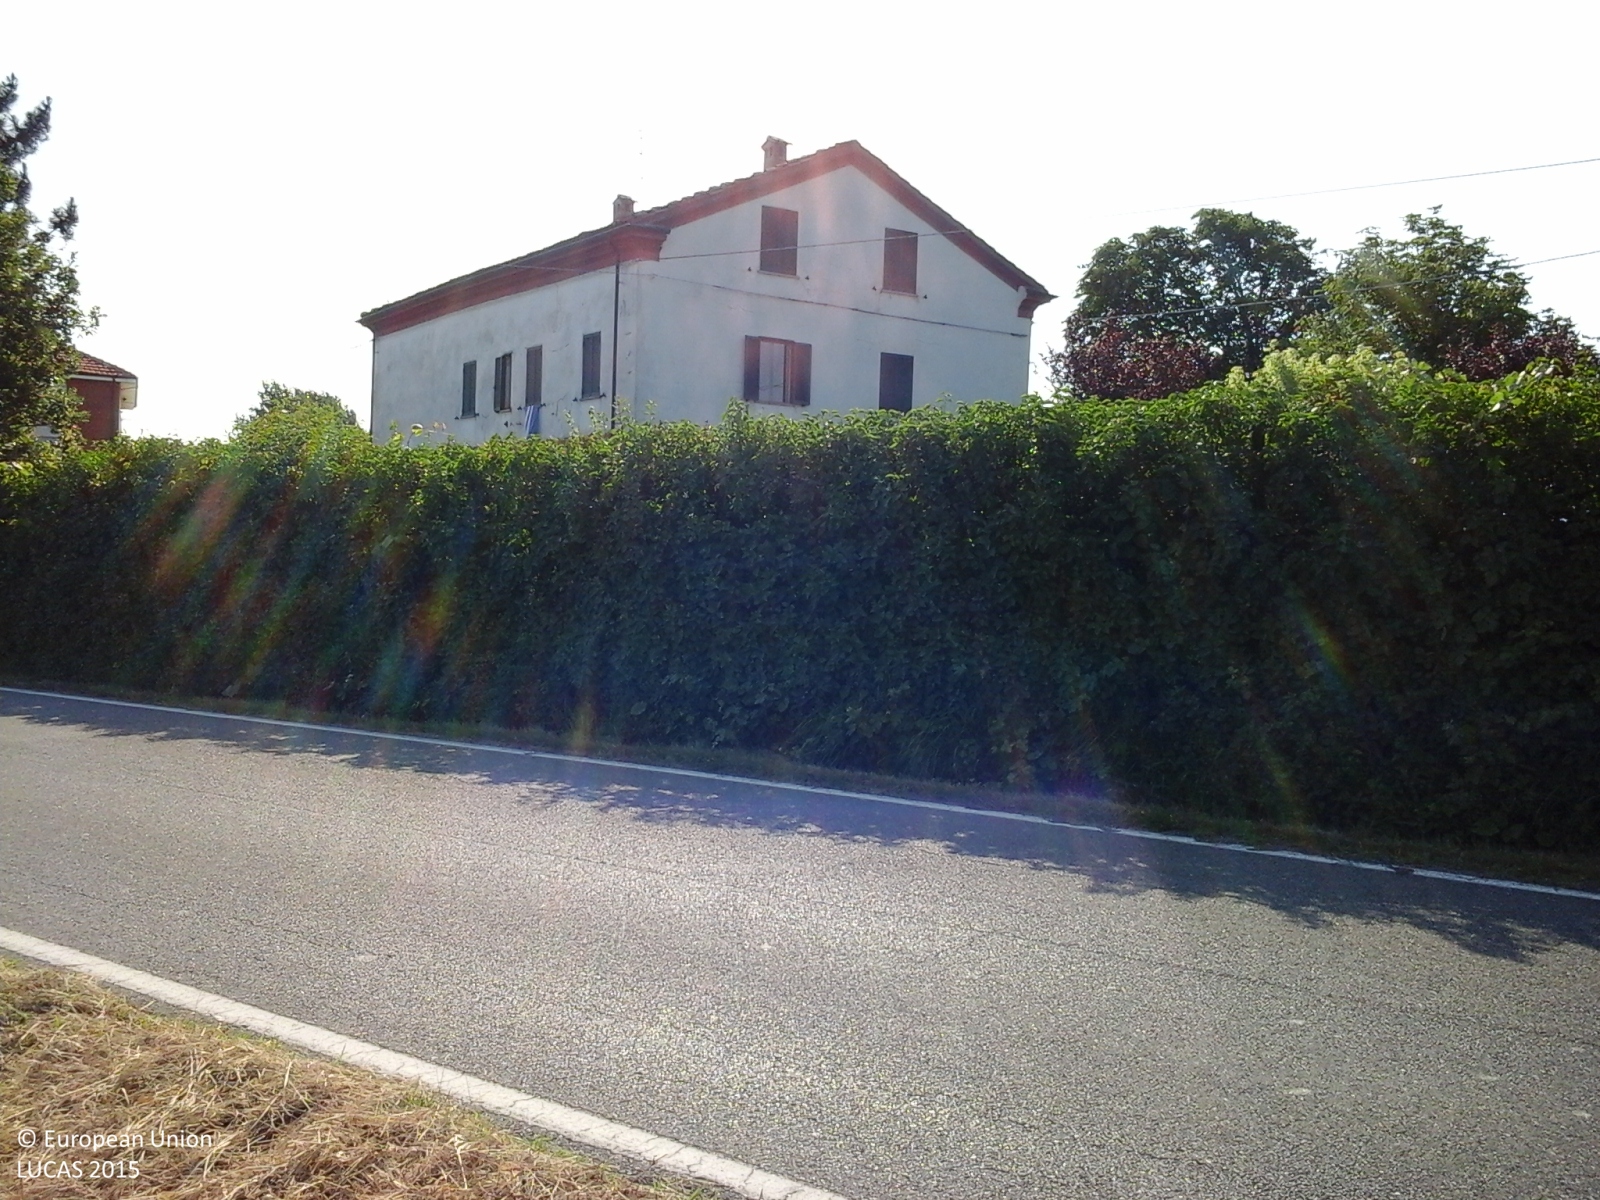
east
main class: Grassland
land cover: Grassland without tree/shrub cover
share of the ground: > 75 %
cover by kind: herbaceous plants 100 %
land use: Agriculture (excluding fallow land and kitchen gardens)
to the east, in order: Grassland without tree/shrub cover; Artificial constructions in urban areas; Vineyards; Grassland without tree/shrub cover; Paved roads, cycling and walking lanes; Lines of trees; Tracks; Vineyards
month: May
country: IT
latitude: 44.7350
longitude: 8.3995
